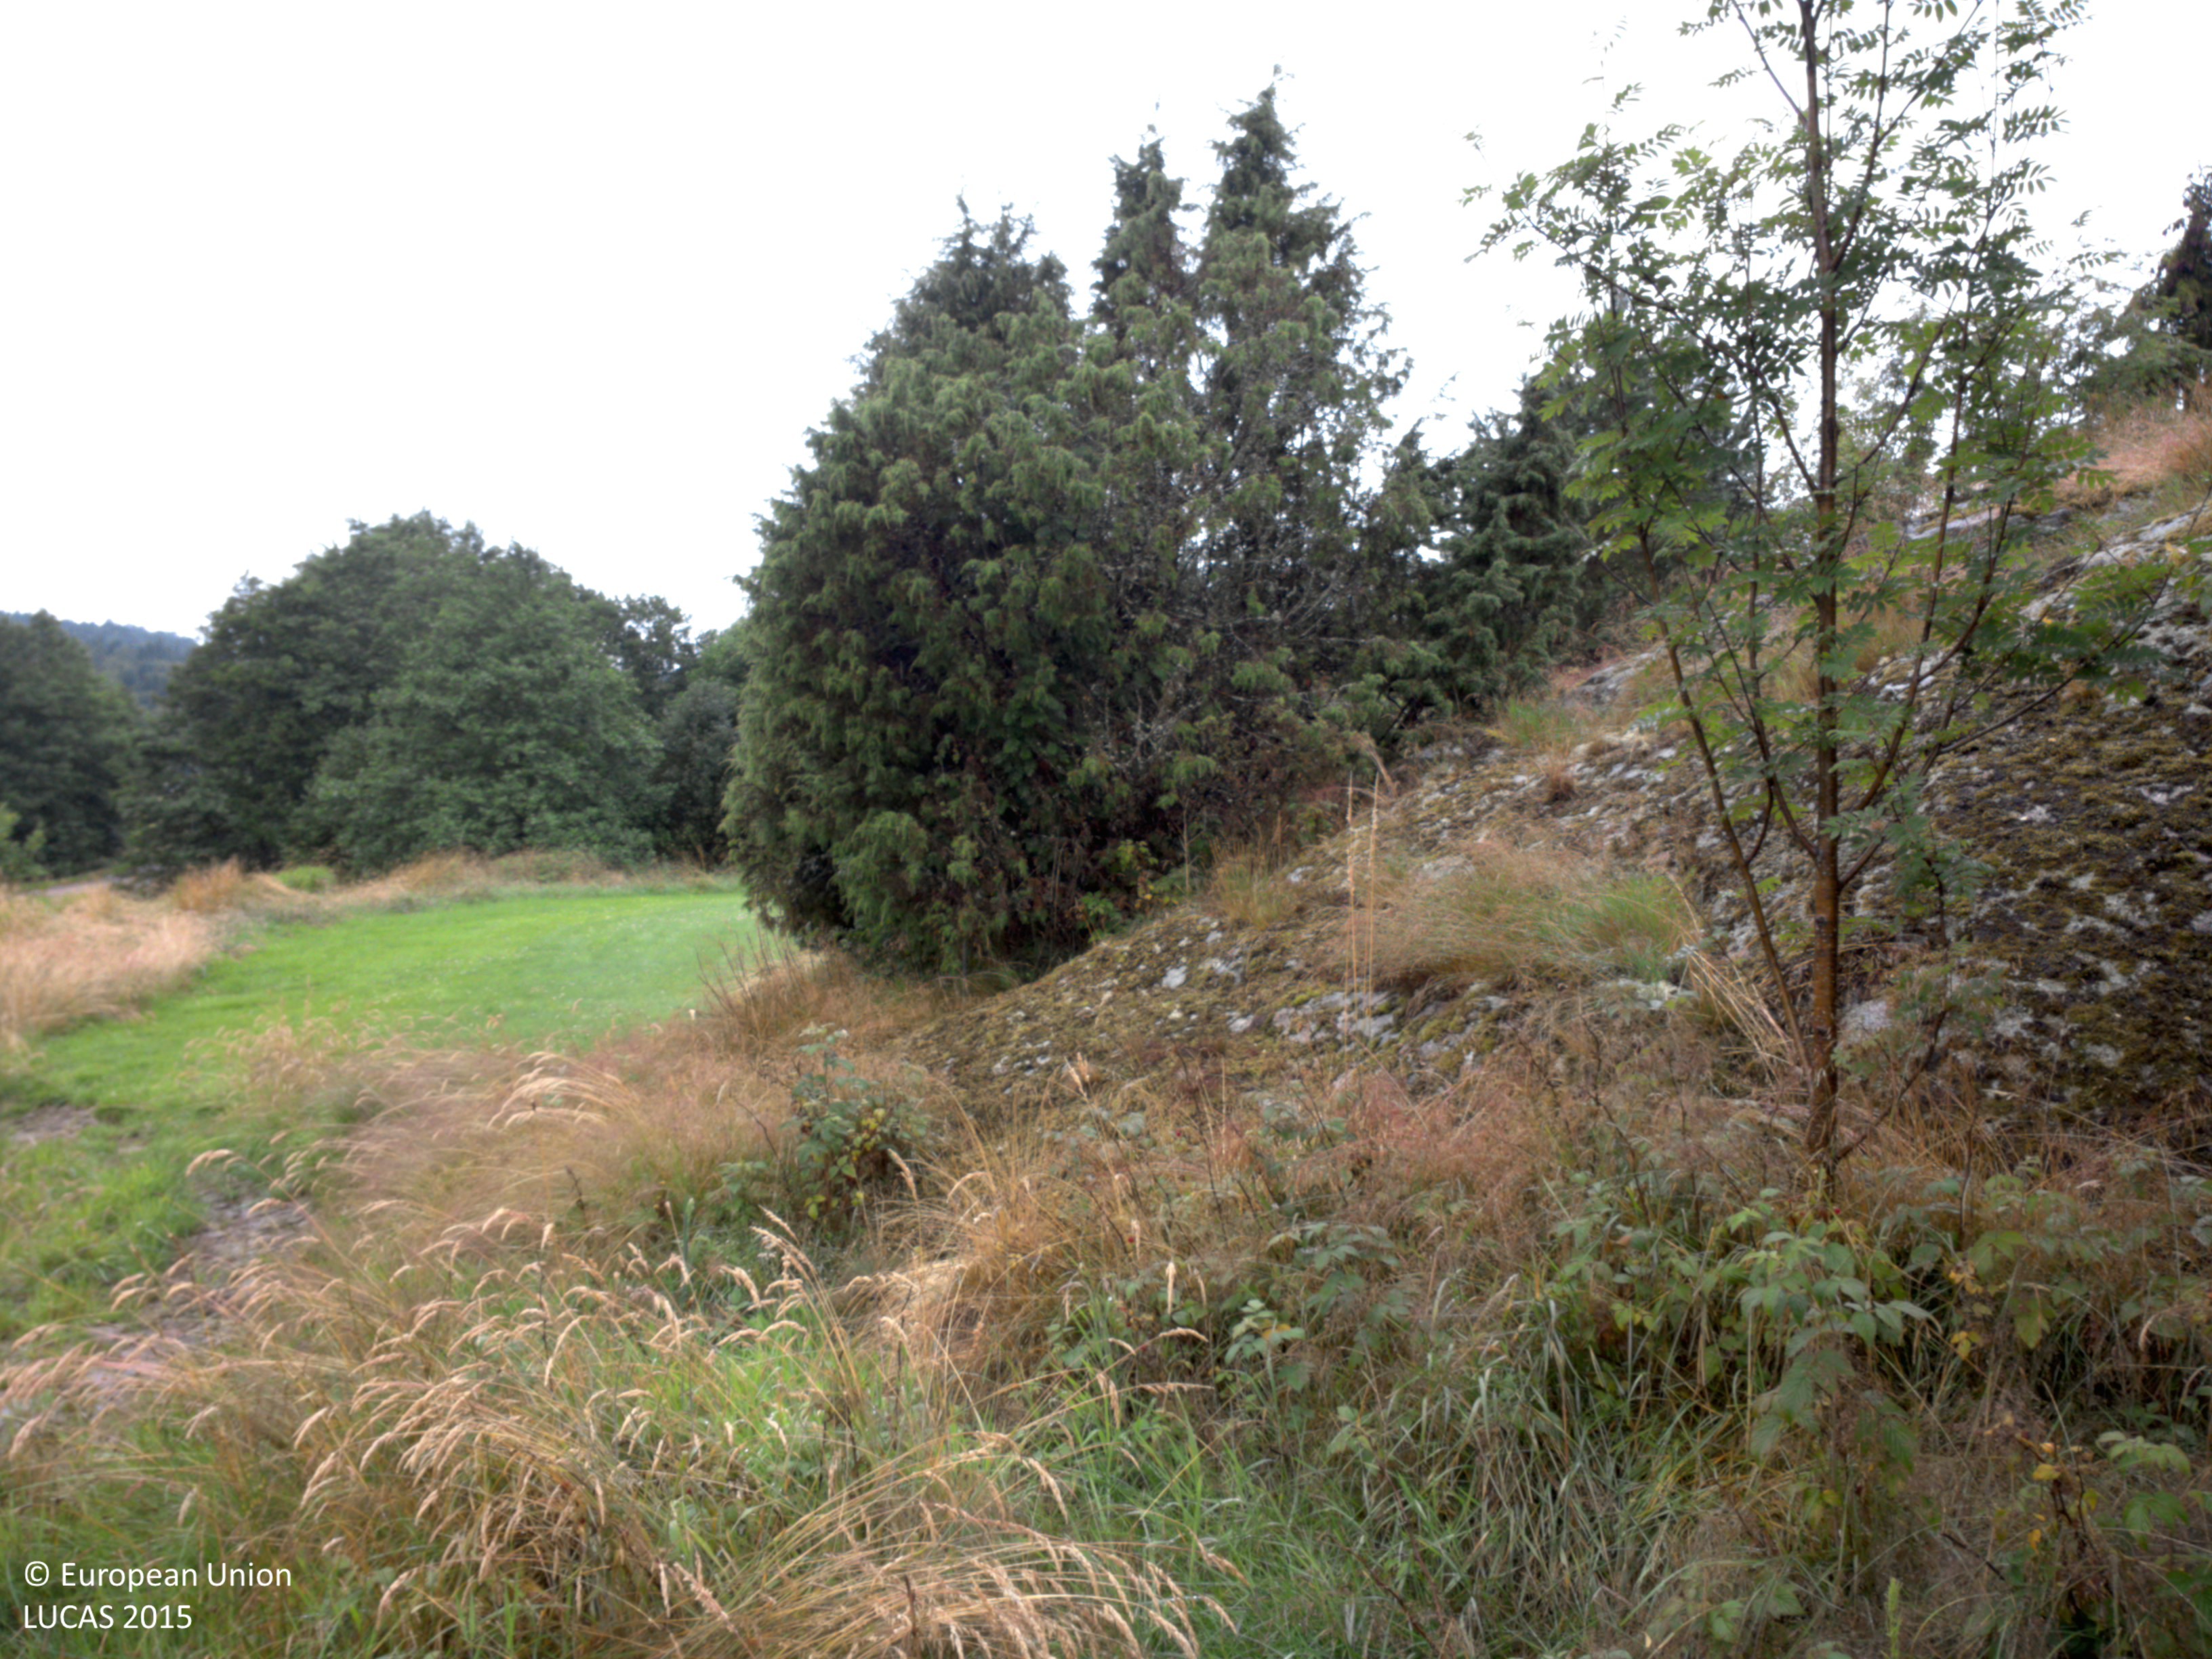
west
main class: Grassland
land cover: Grassland without tree/shrub cover
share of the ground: > 75 %
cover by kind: herbaceous plants 95 %, shrubs 5 %
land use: Abandoned areas
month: July
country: SE
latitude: 58.2947
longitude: 11.9921
